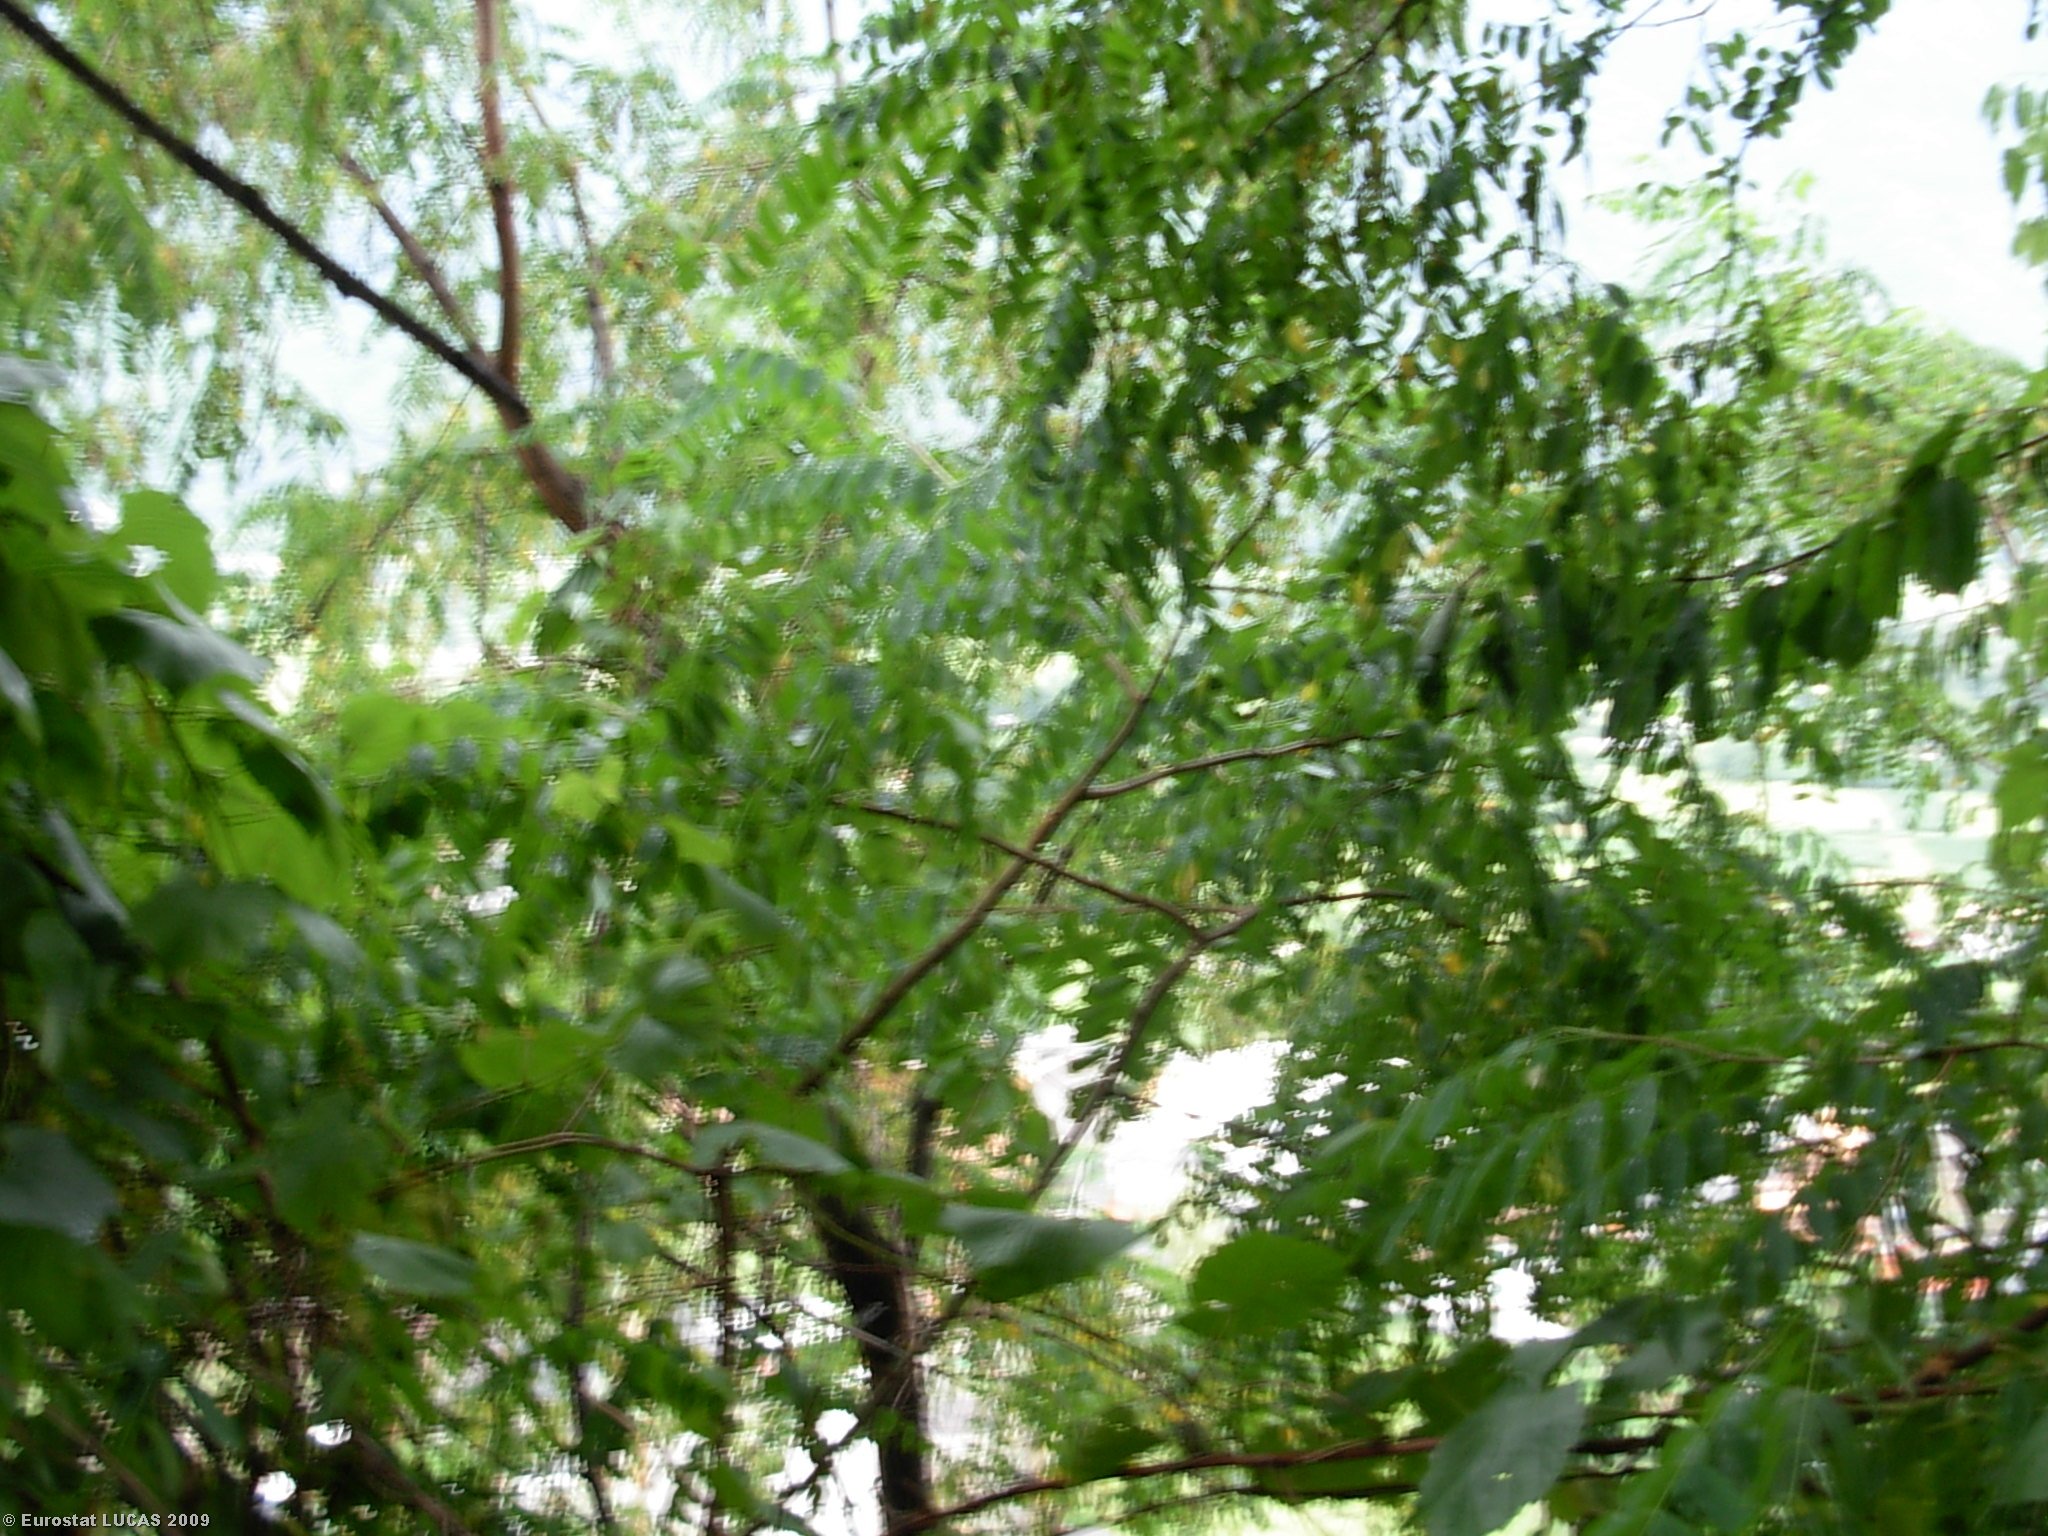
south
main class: Woodland
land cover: Broadleaved woodland
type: mesophytic deciduous forest
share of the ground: > 75 %
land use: Forestry
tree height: > 5 m
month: July
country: IT
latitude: 46.1520
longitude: 9.5216
